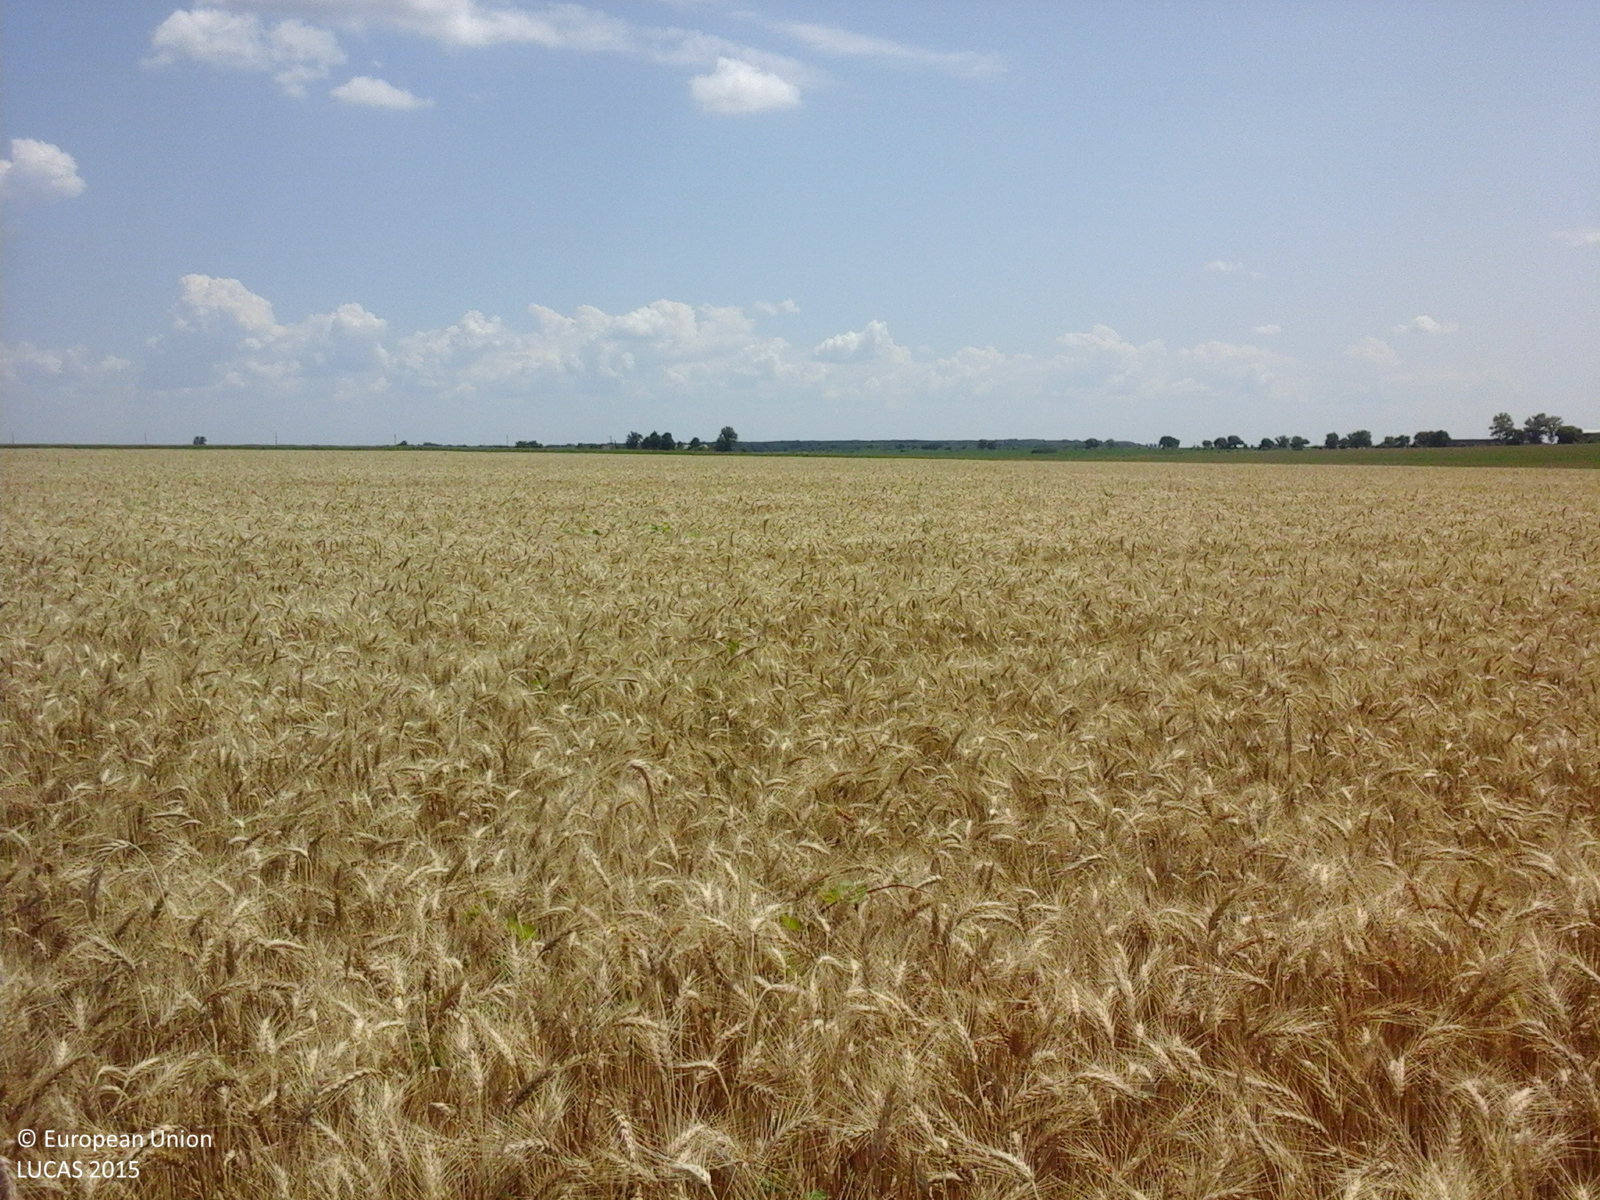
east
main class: Cropland
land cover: Common wheat
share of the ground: > 75 %
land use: Agriculture (excluding fallow land and kitchen gardens)
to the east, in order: Common wheat
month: June
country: RO
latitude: 44.1244
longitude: 26.3670
